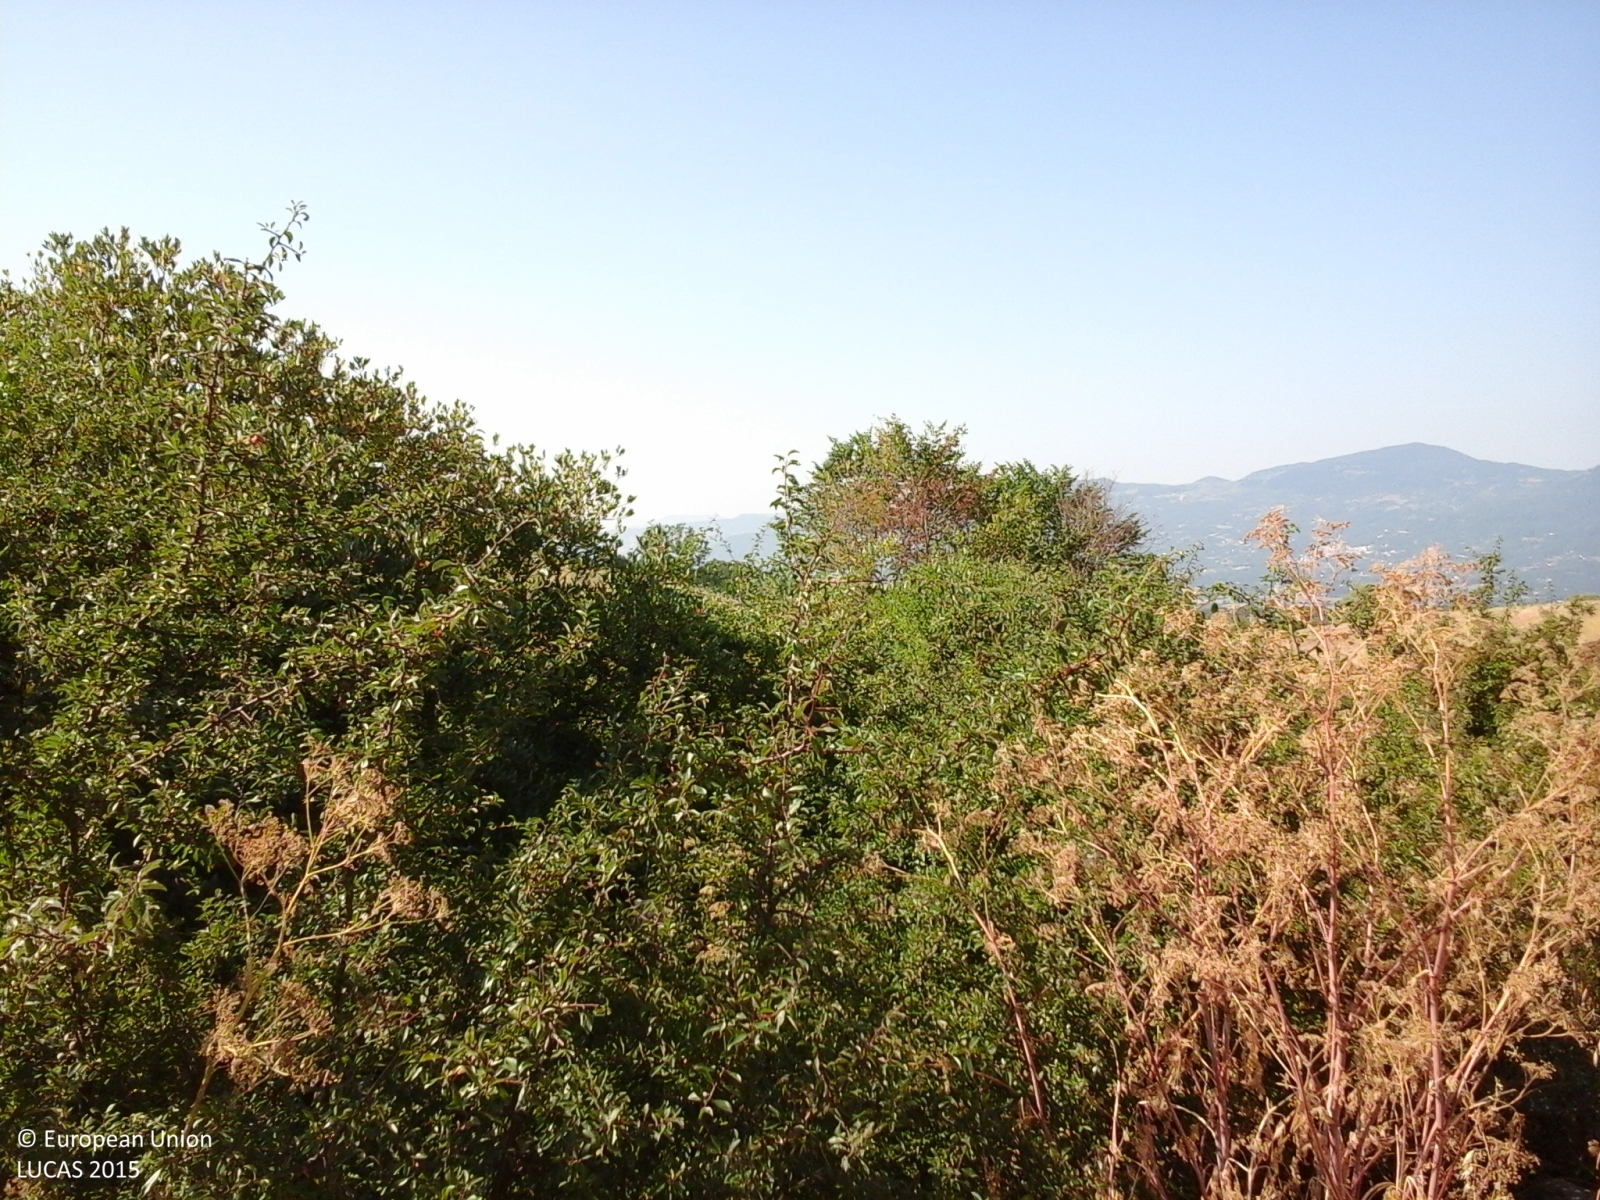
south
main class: Woodland
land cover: Broadleaved woodland
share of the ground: > 75 %
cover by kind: broadleaved forest trees 90 %, shrubs 10 %
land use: Forestry
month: July
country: IT
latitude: 41.4788
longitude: 14.6659
